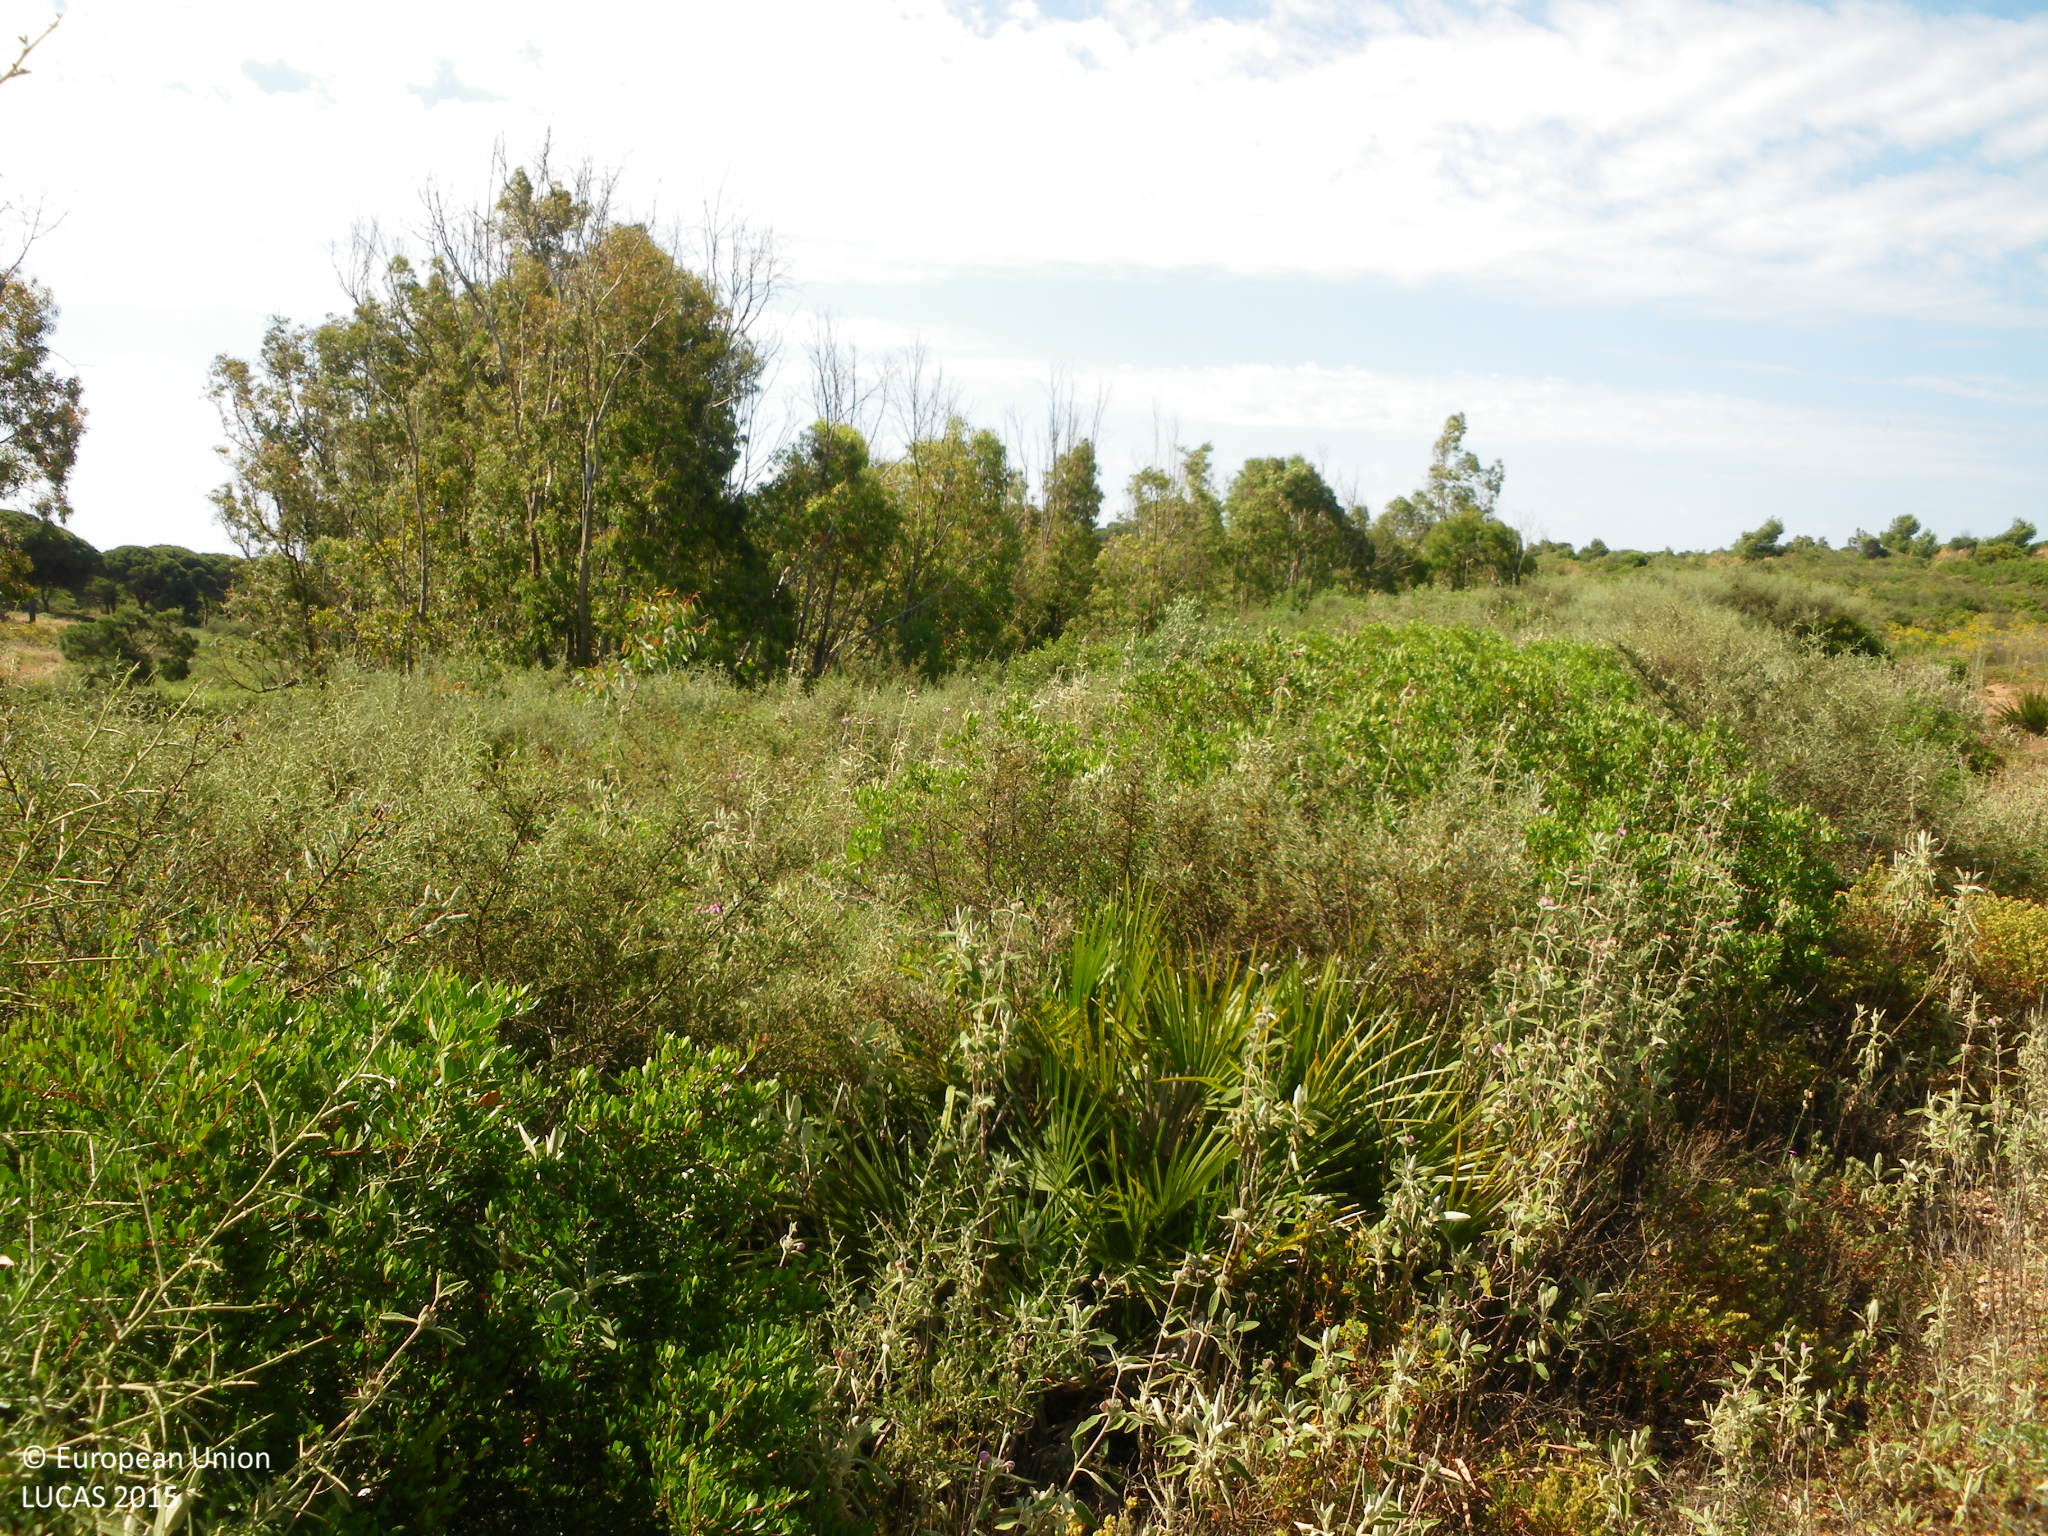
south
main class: Shrubland
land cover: Shrubland with sparse tree cover
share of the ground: > 75 %
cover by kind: shrubs 80 %, herbaceous plants 15 %, broadleaved forest trees 5 %
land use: Semi-natural and natural areas not in use
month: May
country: ES
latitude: 36.3034
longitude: -6.1410
